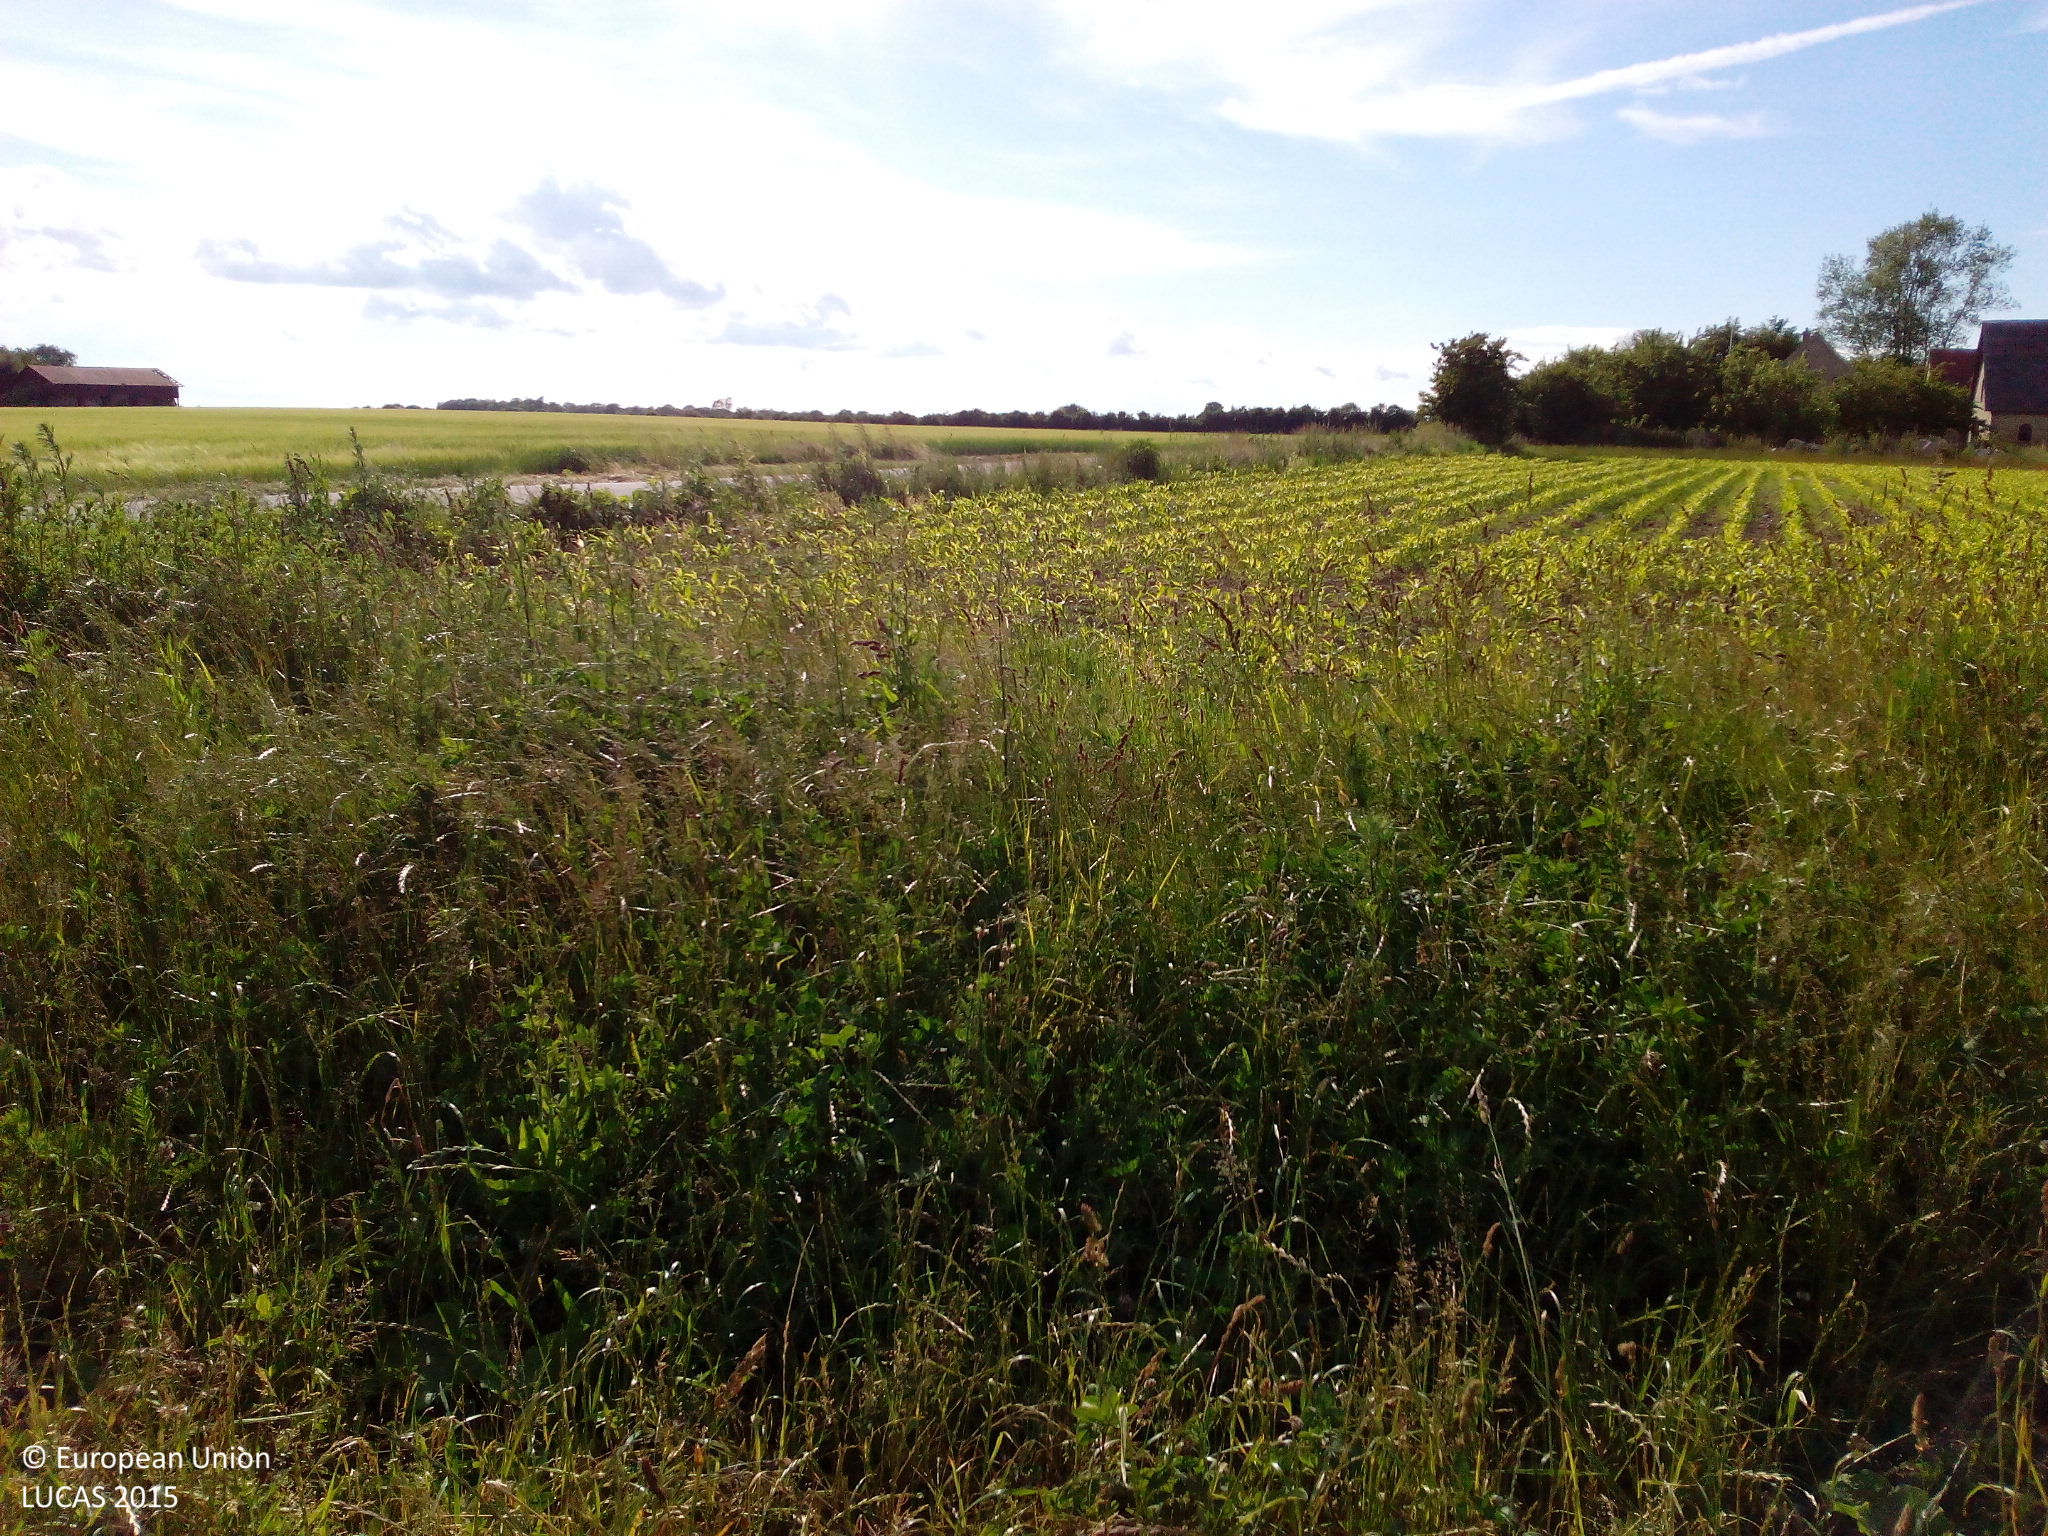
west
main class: Grassland
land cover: Spontaneously vegetated surfaces
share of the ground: > 75 %
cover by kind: herbaceous plants 100 %
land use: Semi-natural and natural areas not in use
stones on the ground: < 10 %
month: June
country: DK
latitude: 54.7555
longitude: 11.7547
